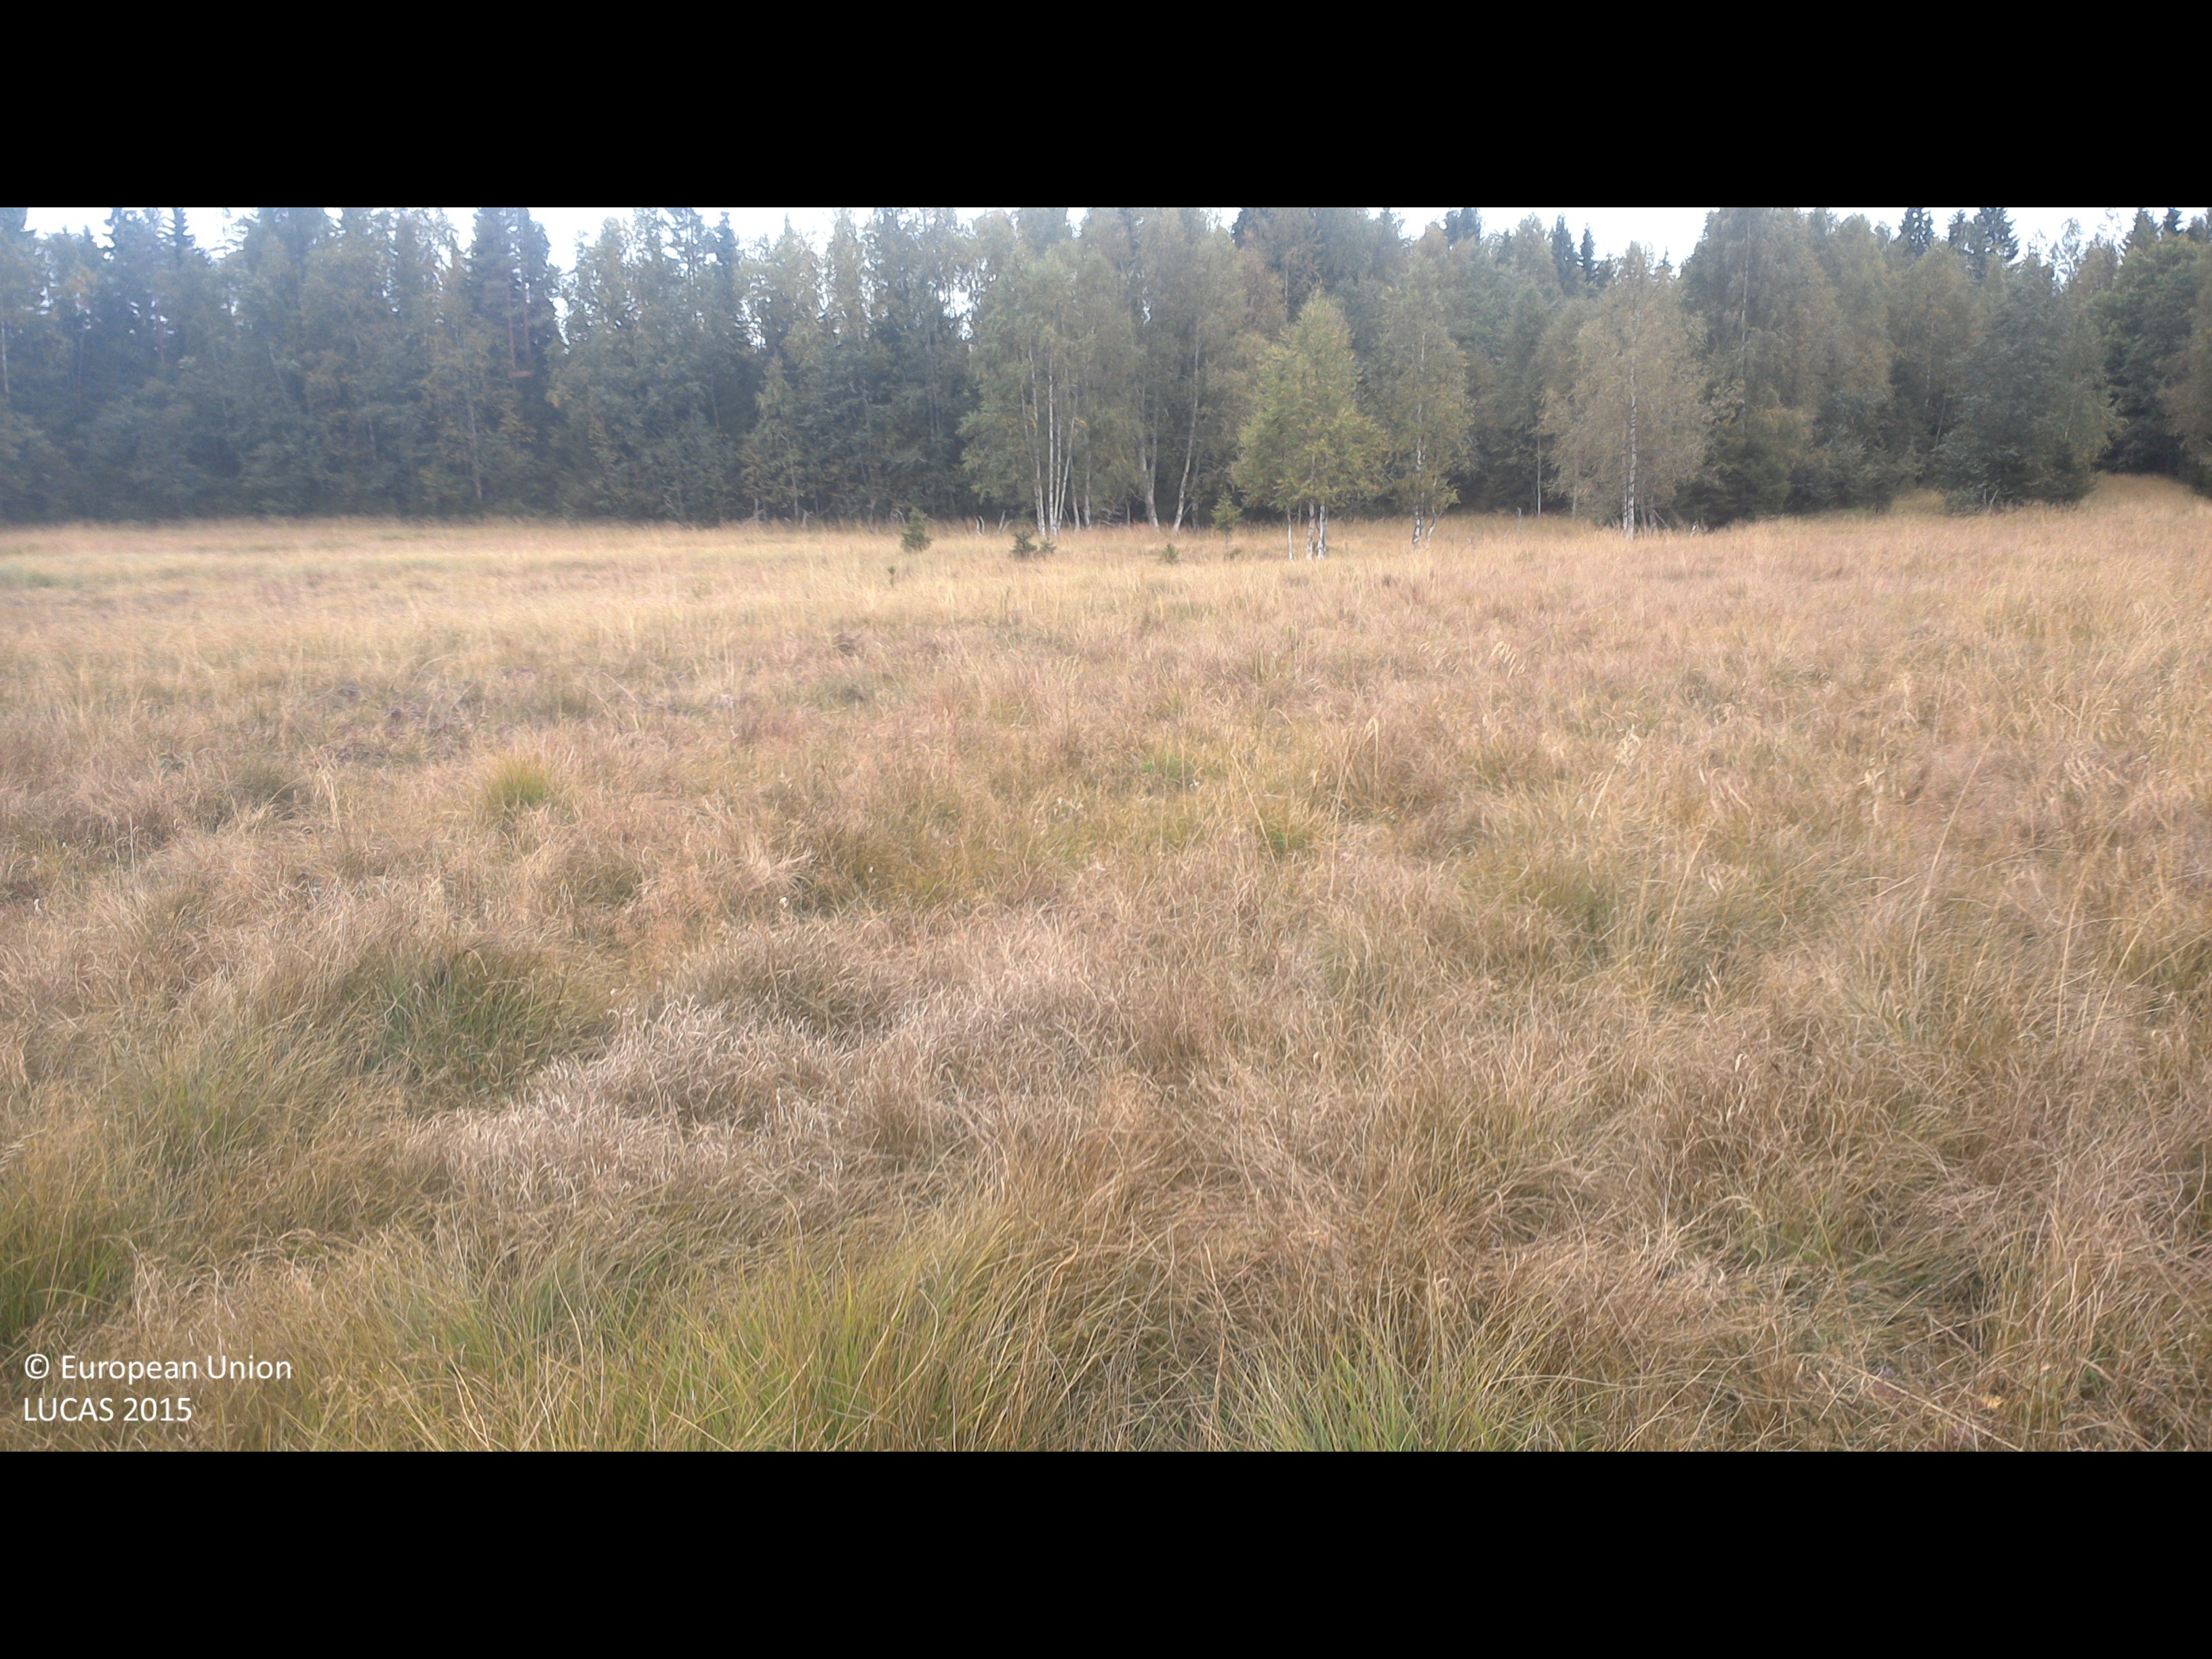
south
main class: Grassland
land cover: Grassland without tree/shrub cover
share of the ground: > 75 %
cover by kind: herbaceous plants 100 %
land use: Agriculture (excluding fallow land and kitchen gardens)
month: September
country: SE
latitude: 63.7807
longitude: 19.5739
